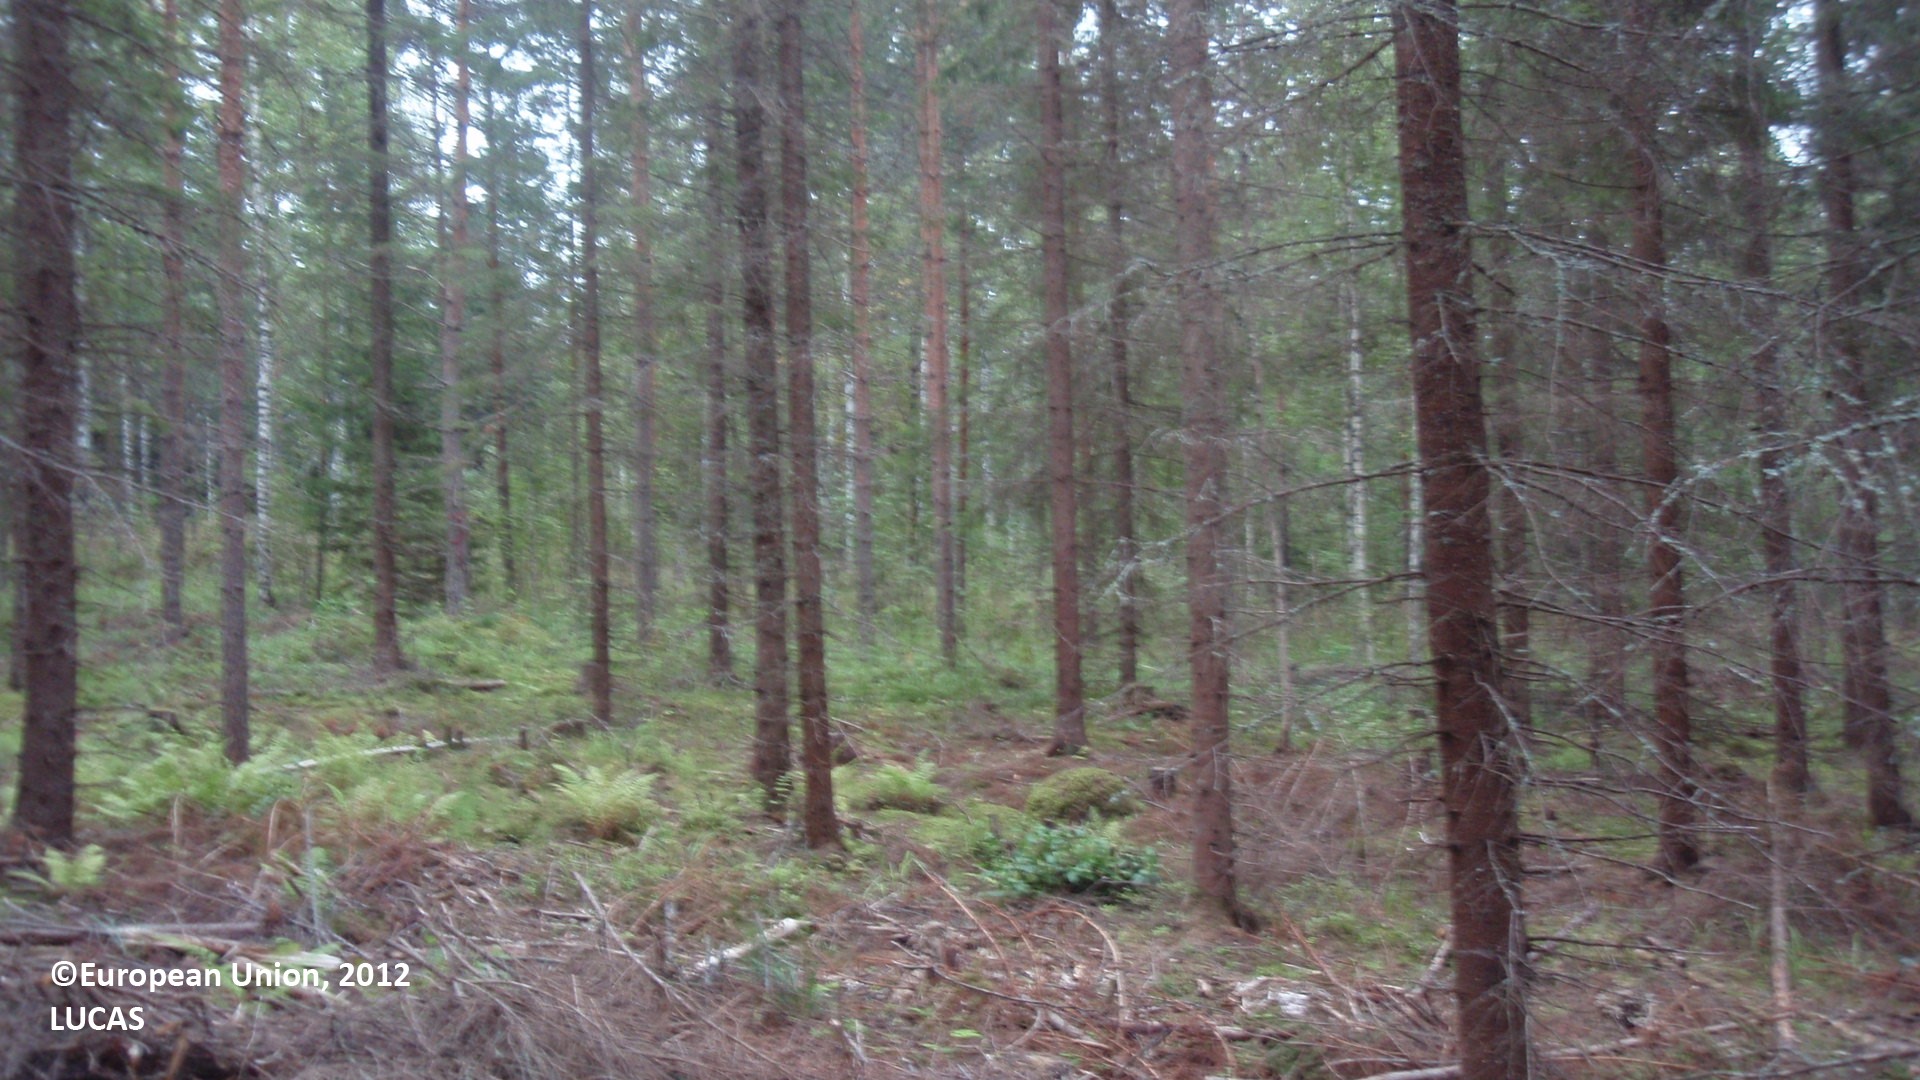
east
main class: Woodland
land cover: Spruce dominated coniferous woodland
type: boreal forest
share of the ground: 50 - 75 %
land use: Forestry
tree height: > 5 m
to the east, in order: Spruce dominated coniferous woodland; Pine dominated mixed woodland; Spruce dominated coniferous woodland; Pine dominated mixed woodland; Spruce dominated mixed woodland
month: August
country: FI
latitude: 61.1798
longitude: 26.6109
